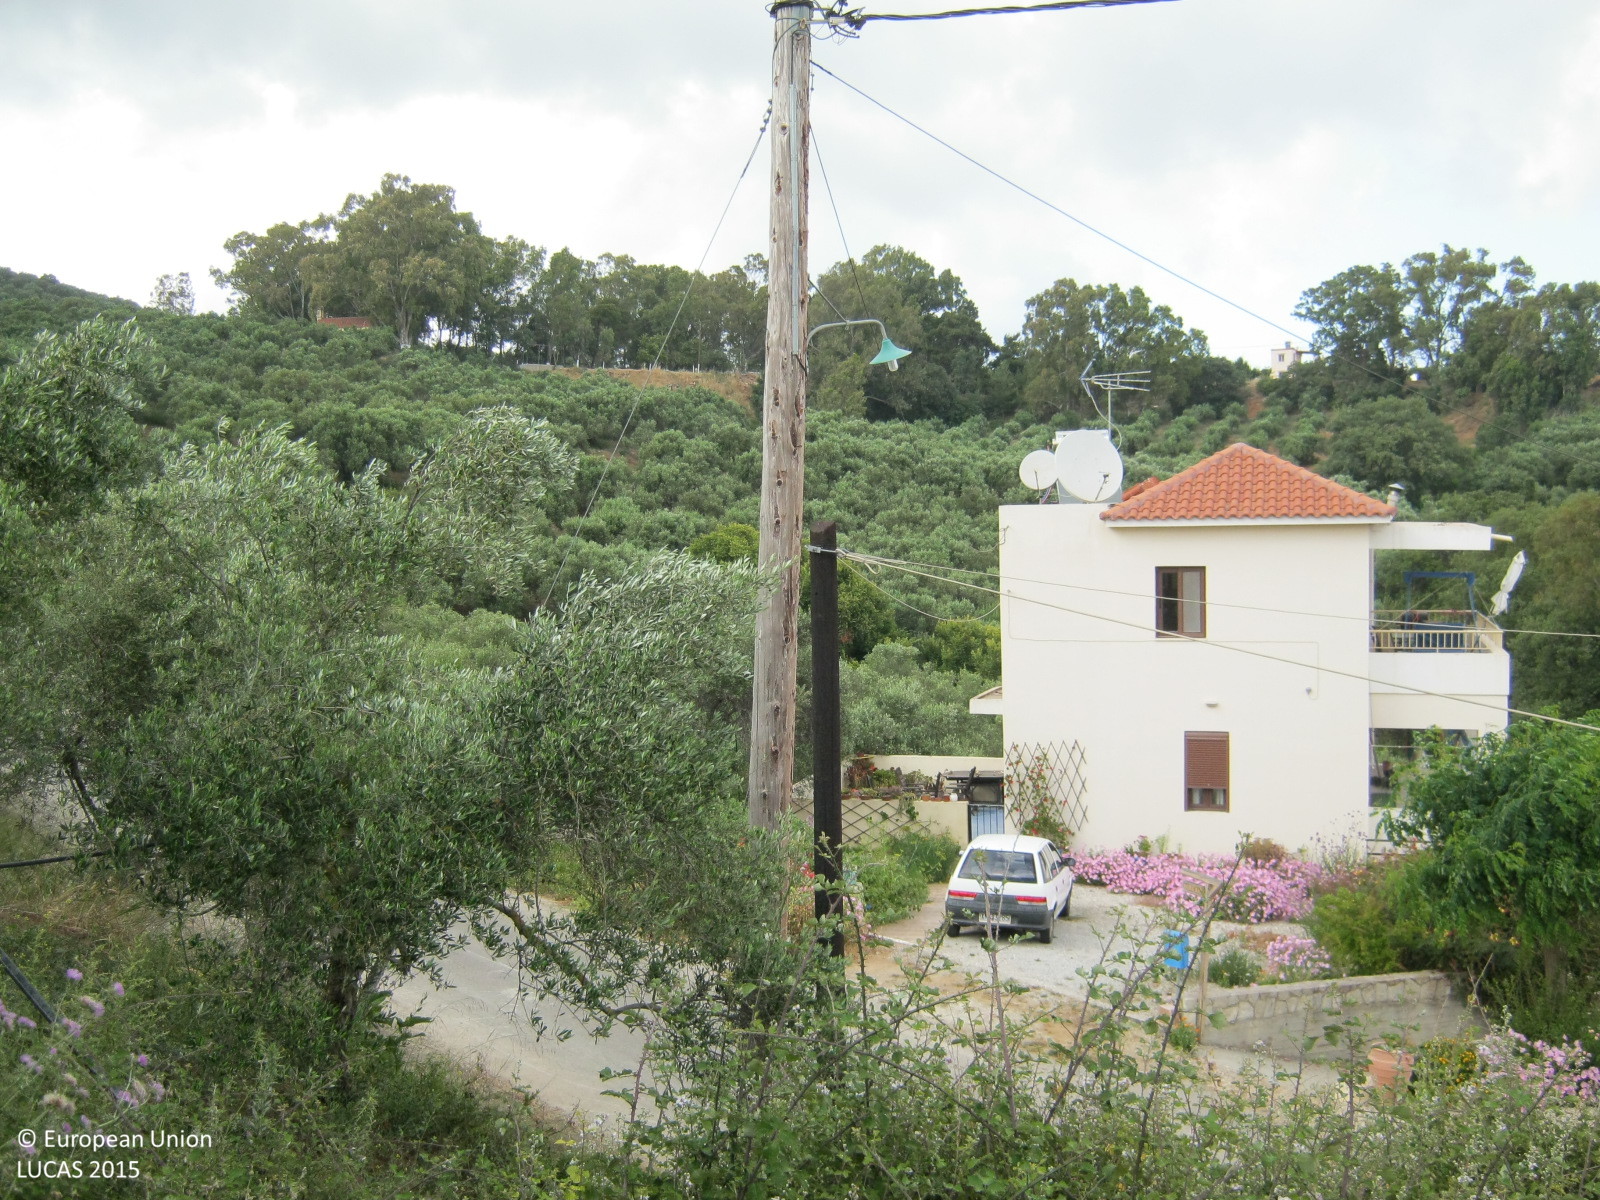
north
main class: Cropland
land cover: Olive groves
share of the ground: > 75 %
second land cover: Spontaneously vegetated surfaces
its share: > 75 %
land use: Agriculture (excluding fallow land and kitchen gardens)
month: May
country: GR
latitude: 35.4867
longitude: 23.7949
